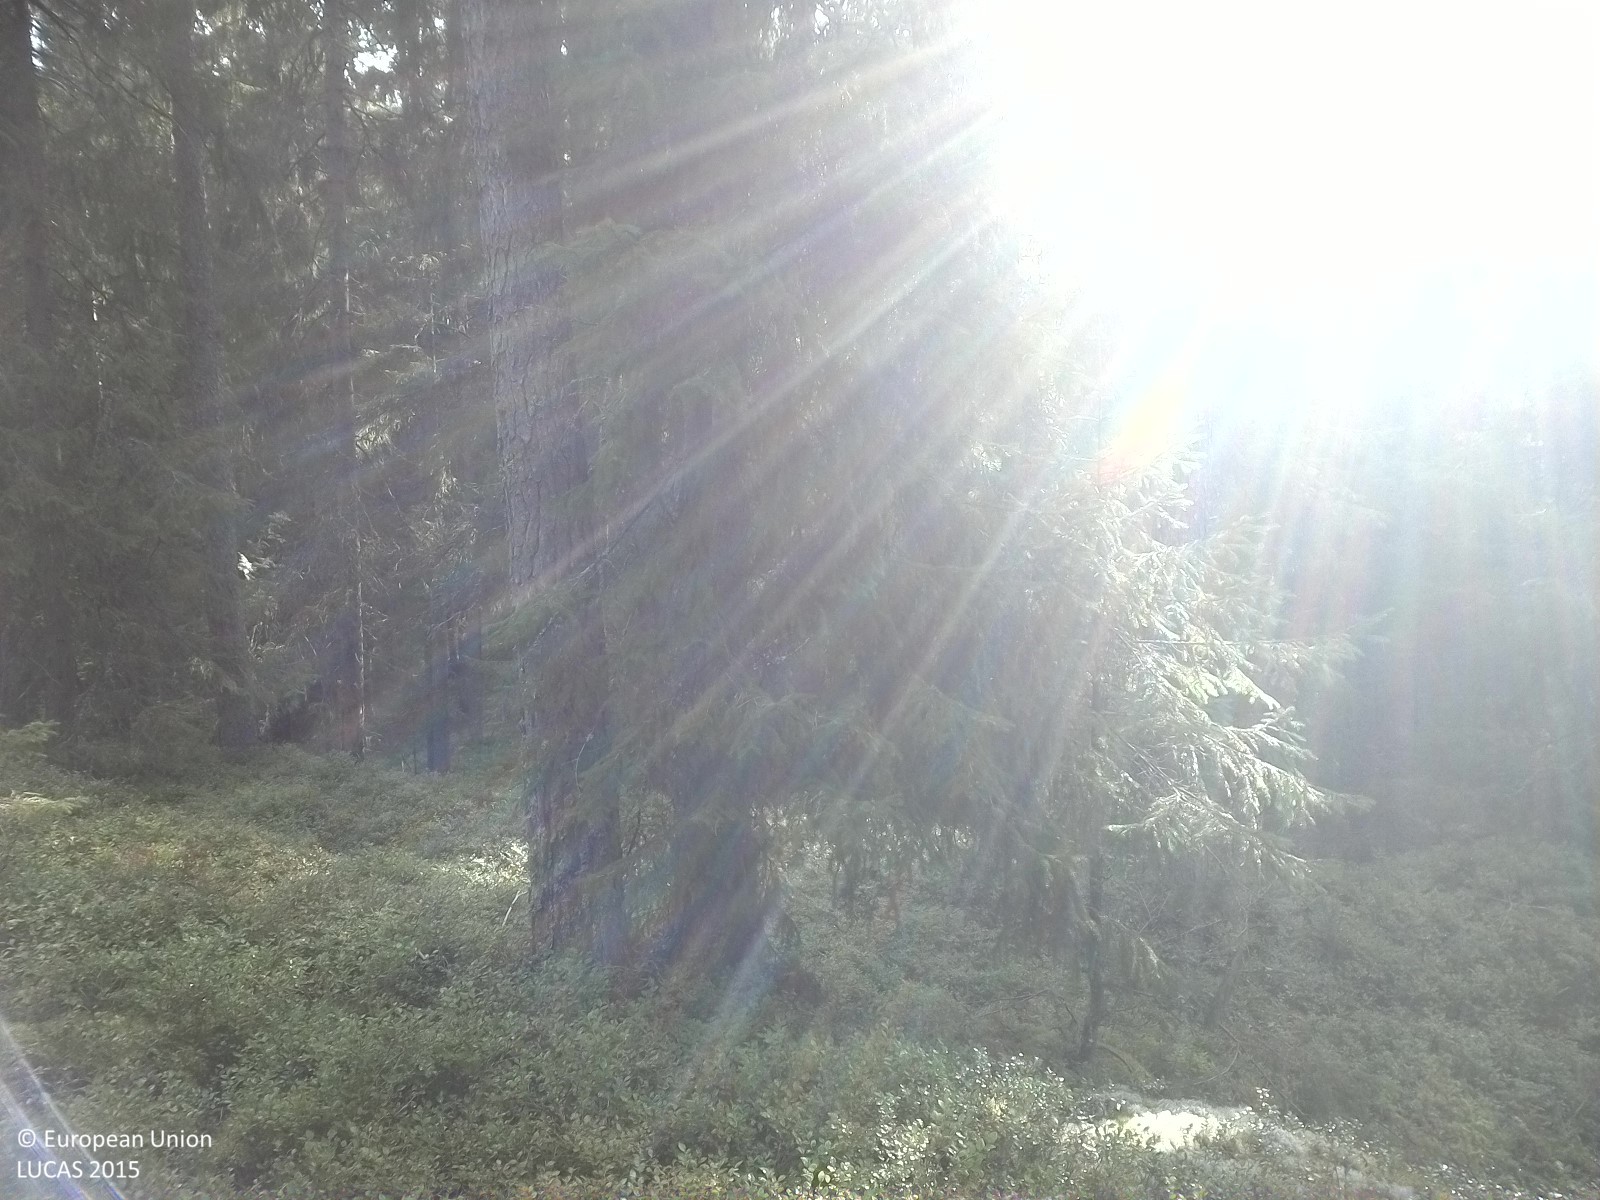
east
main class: Woodland
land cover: Pine dominated coniferous woodland
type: boreal forest
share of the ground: 25 - 50 %
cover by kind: shrubs 60 %, coniferous forest trees 25 %, herbaceous plants 10 %, lichens and mosses 5 %
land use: Forestry
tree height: > 5 m
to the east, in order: Pine dominated coniferous woodland; Spruce dominated coniferous woodland; Tracks; Spruce dominated coniferous woodland; Rivers and streams; Spruce dominated coniferous woodland; Broadleaved woodland; Rivers and streams; Broadleaved woodland; Spruce dominated coniferous woodland; Spruce dominated mixed woodland
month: August
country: SE
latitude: 58.7195
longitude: 15.0524
